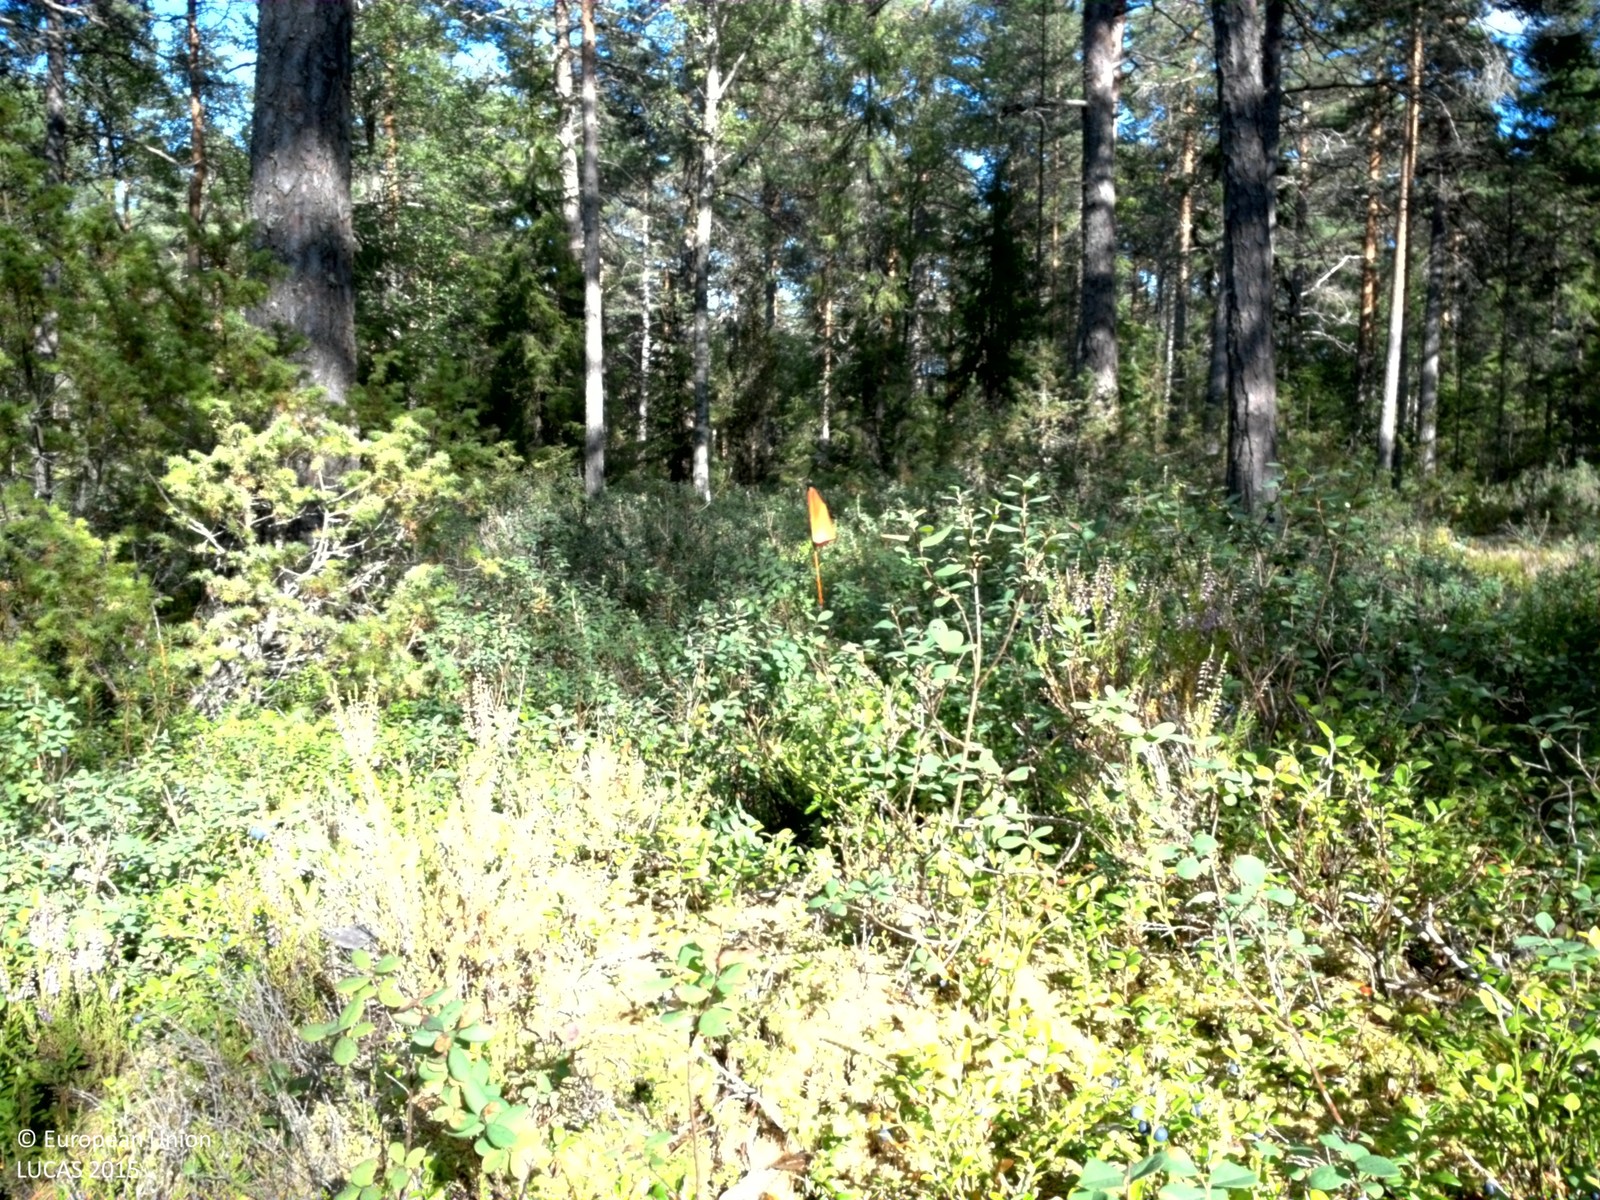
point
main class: Woodland
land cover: Pine dominated coniferous woodland
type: boreal forest
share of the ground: 50 - 75 %
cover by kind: coniferous forest trees 60 %, shrubs 20 %, lichens and mosses 20 %
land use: Forestry
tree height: > 5 m
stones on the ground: 10 - 25 %
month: August
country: SE
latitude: 59.9573
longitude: 16.5269
